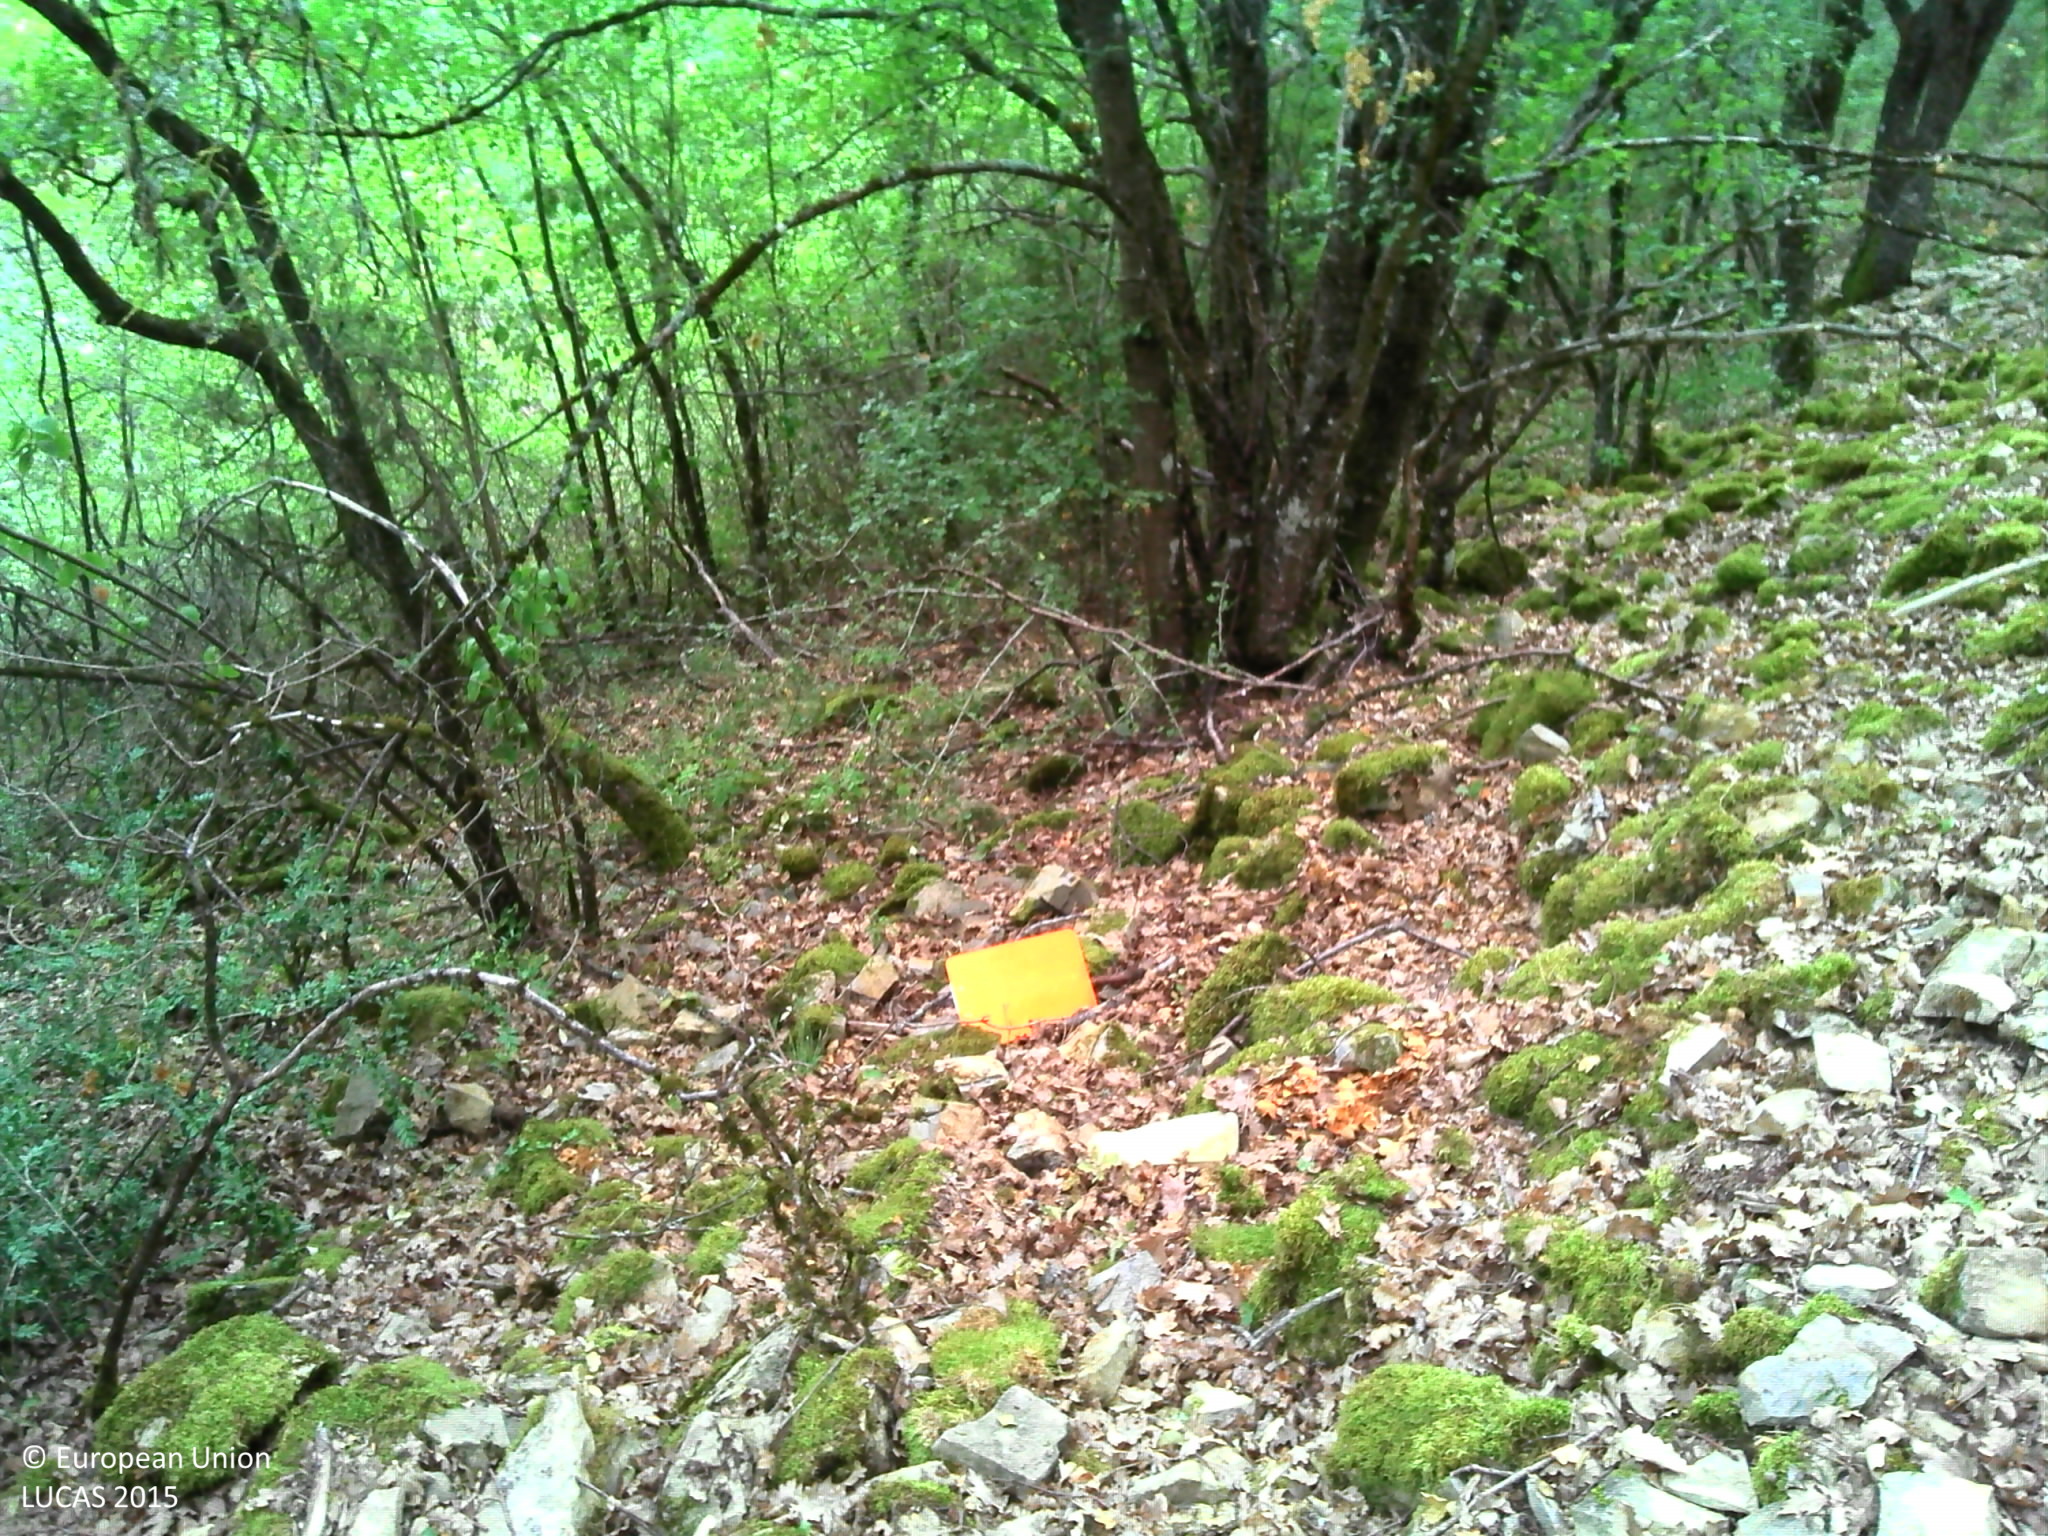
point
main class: Woodland
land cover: Broadleaved woodland
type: mesophytic deciduous forest
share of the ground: > 75 %
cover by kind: broadleaved forest trees 65 %, lichens and mosses 15 %, herbaceous plants 10 %, unconsolidated bare surface 10 %
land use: Forestry
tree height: > 5 m
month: August
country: FR
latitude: 44.0438
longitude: 3.3048
